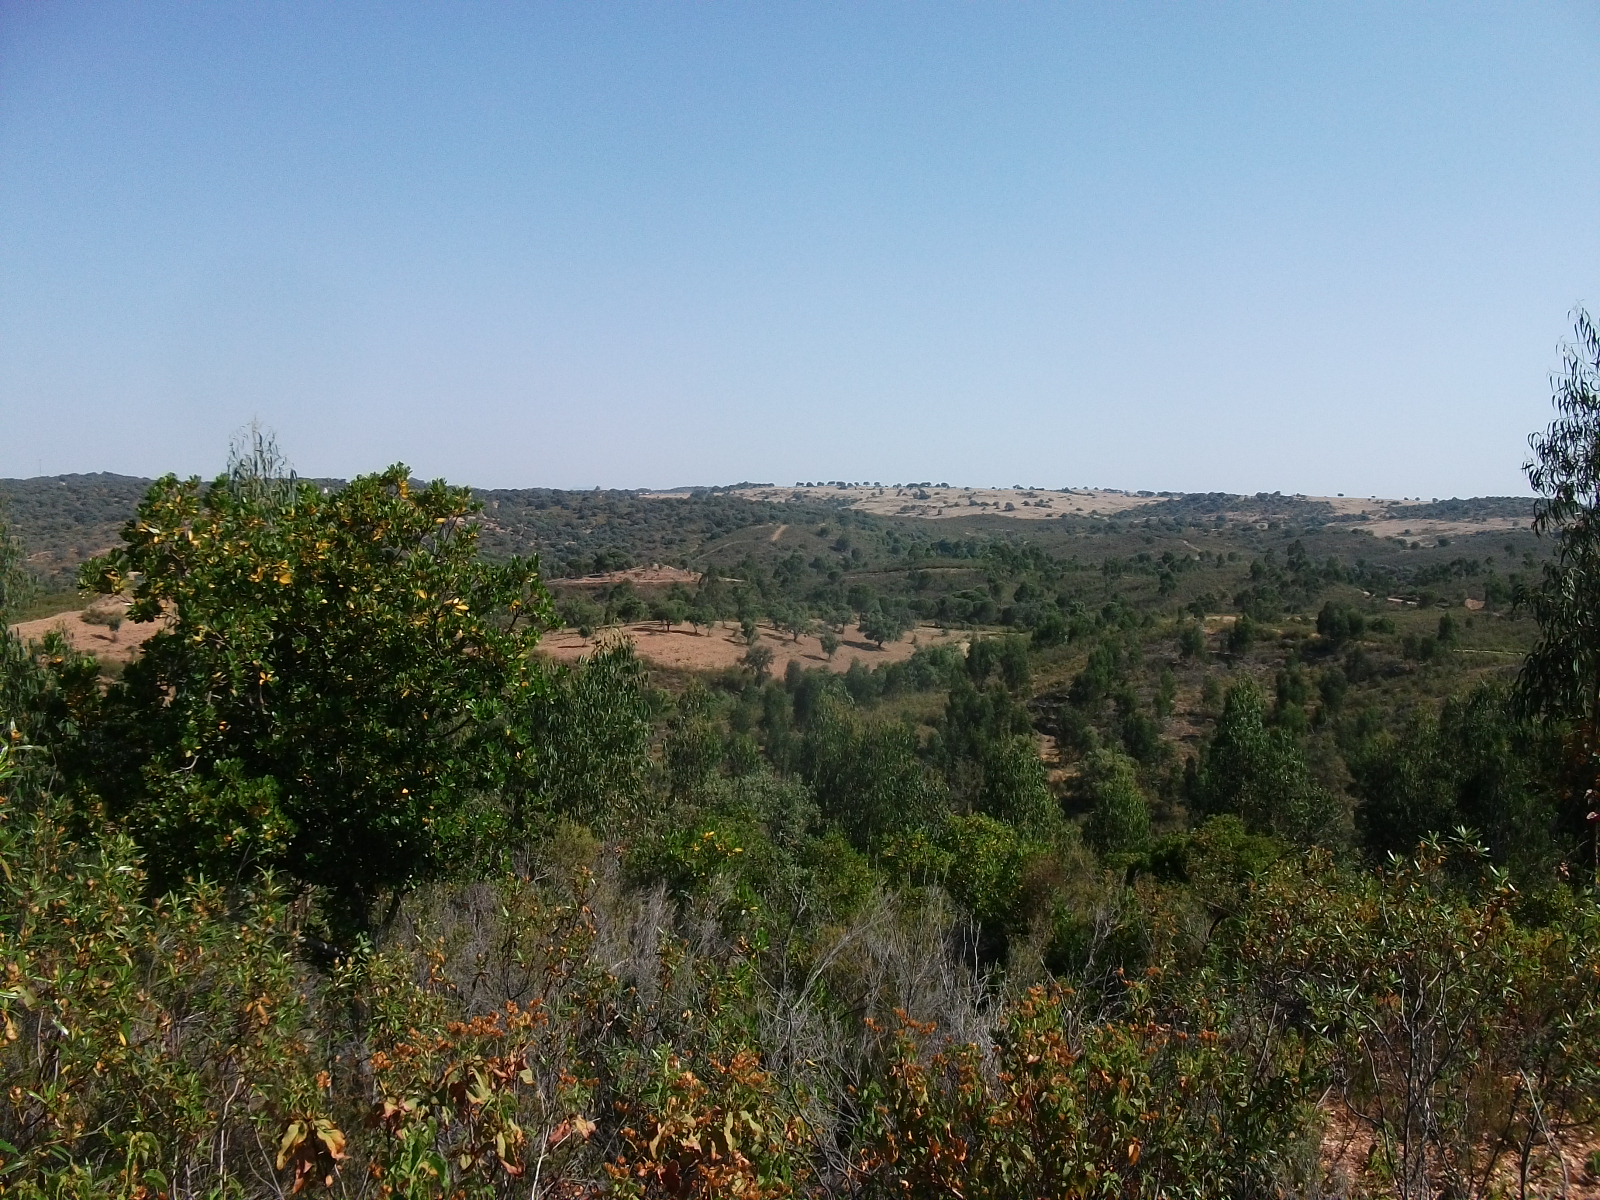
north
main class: Woodland
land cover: Broadleaved woodland
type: exotic forest
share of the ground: 50 - 75 %
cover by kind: broadleaved forest trees 60 %, shrubs 30 %, unconsolidated bare surface 10 %
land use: Forestry
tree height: > 5 m
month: May
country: ES
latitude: 37.5968
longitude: -6.6549
